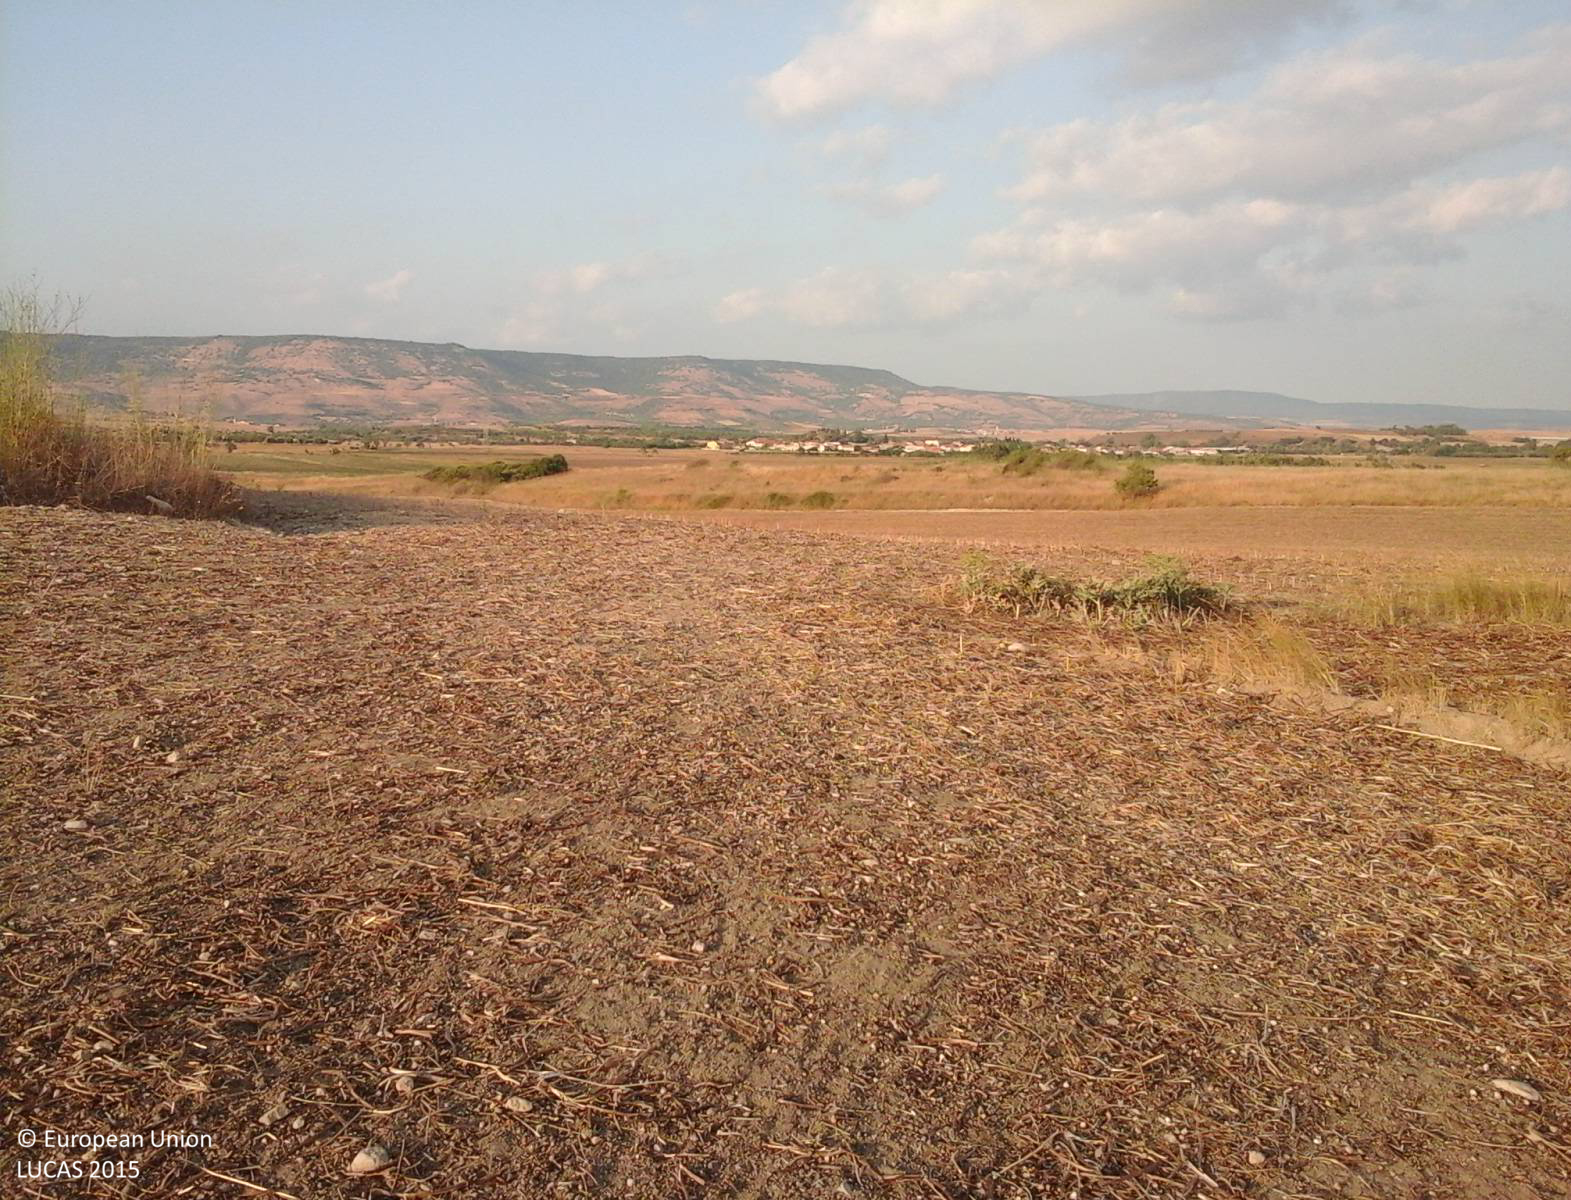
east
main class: Cropland
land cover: Dry pulses
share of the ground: > 75 %
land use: Agriculture (excluding fallow land and kitchen gardens)
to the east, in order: Dry pulses; Grass margins; Oats; Grassland without tree/shrub cover; Oats
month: July
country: IT
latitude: 39.6998
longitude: 8.8984
